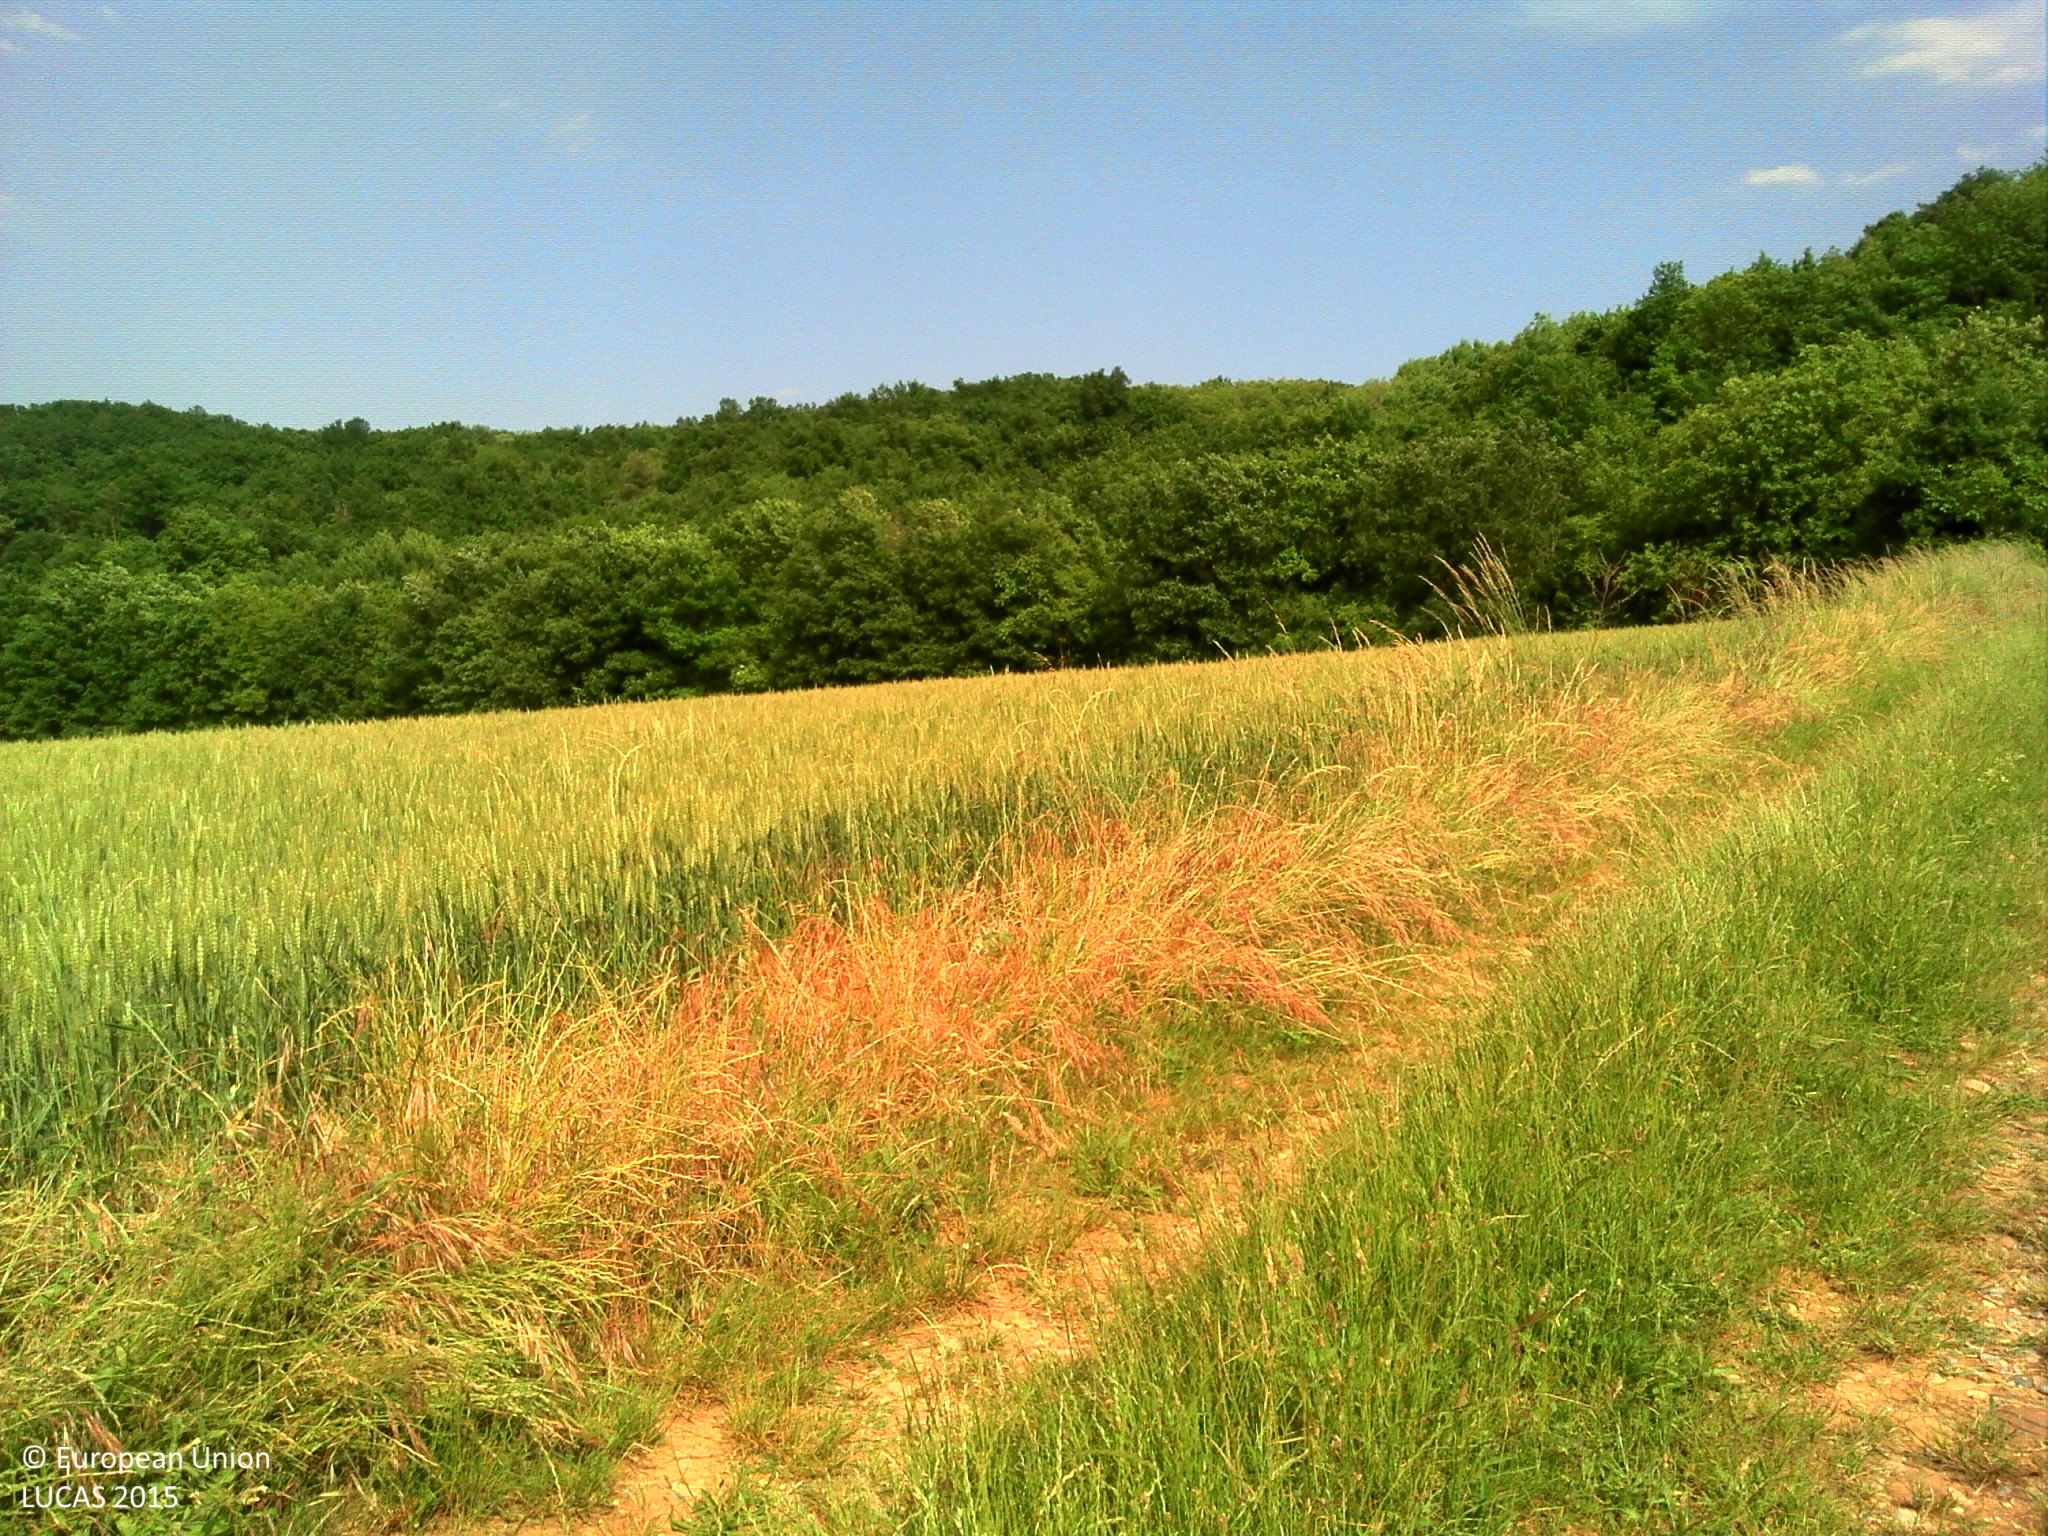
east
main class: Cropland
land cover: Durum wheat
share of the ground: > 75 %
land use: Agriculture (excluding fallow land and kitchen gardens)
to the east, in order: Durum wheat; Paved roads, cycling and walking lanes; Managed hedges; Grassland without tree/shrub cover; Broadleaved woodland; Grassland with sparse tree/shrub cover
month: May
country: FR
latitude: 45.1156
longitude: 5.0097
